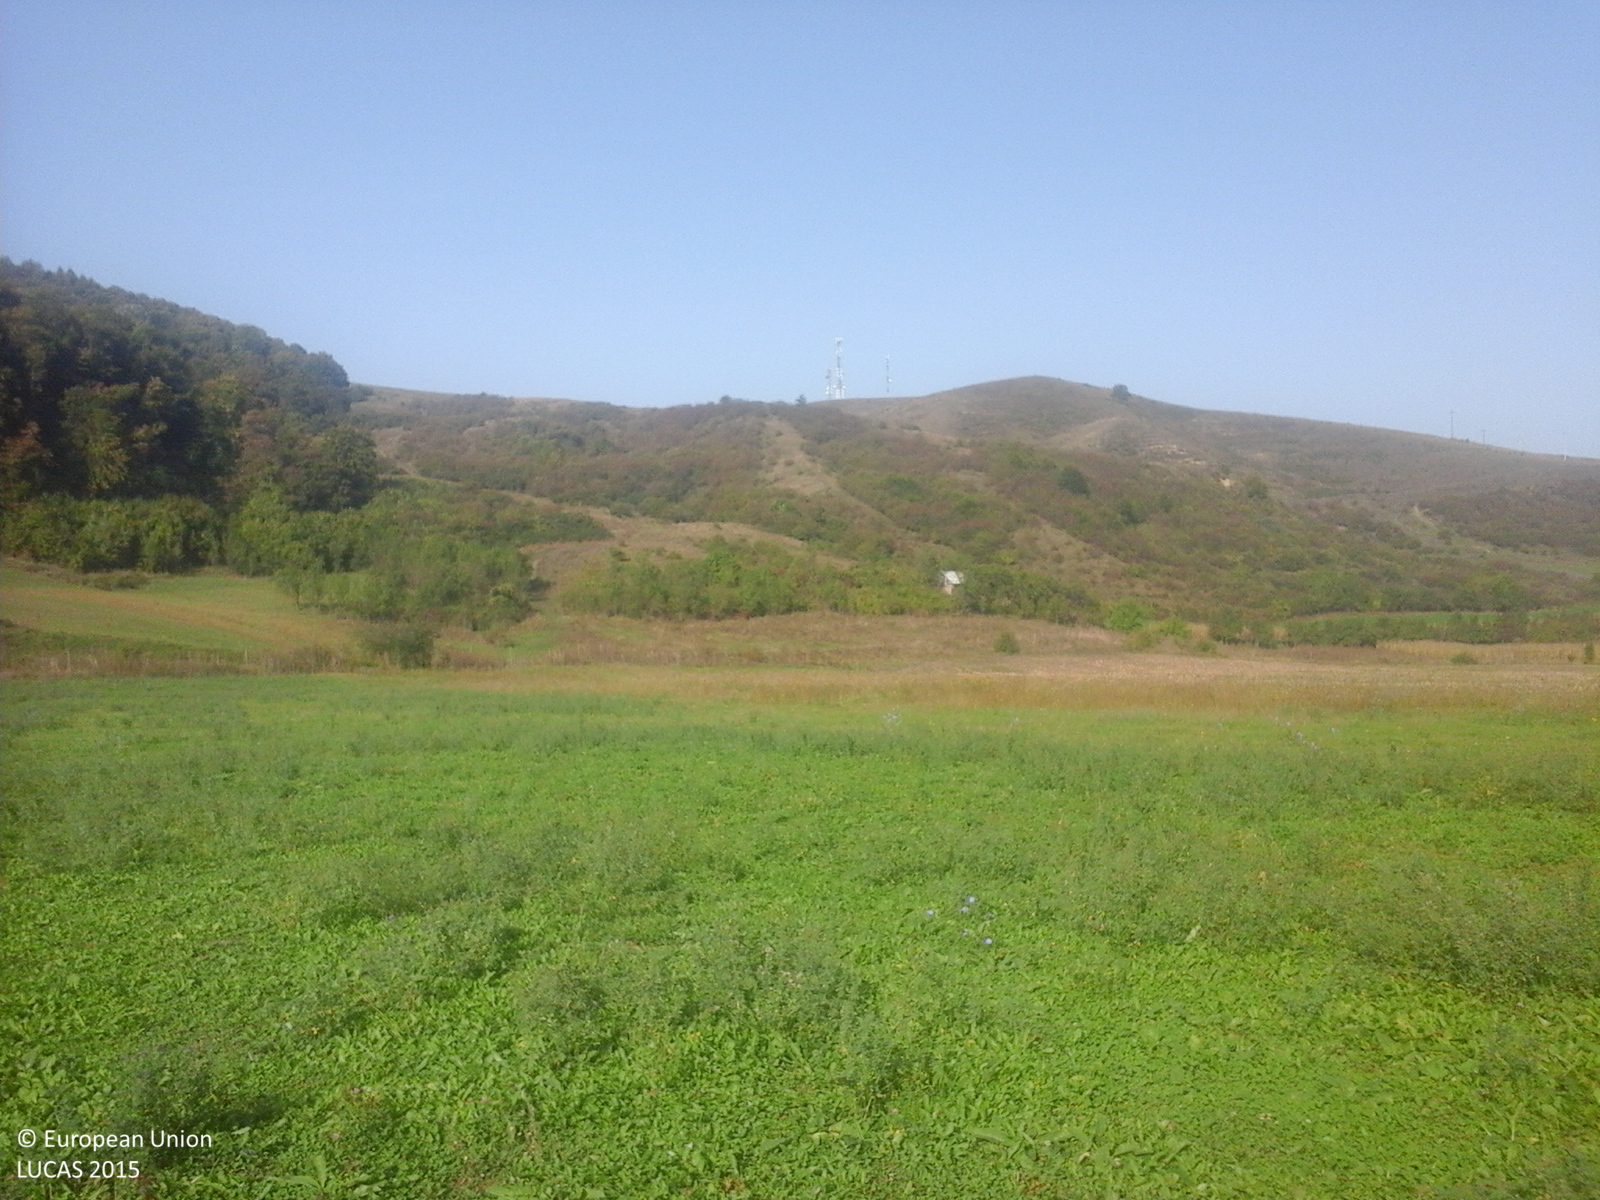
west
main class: Cropland
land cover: Other leguminous and mixtures for fodder
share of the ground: > 75 %
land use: Agriculture (excluding fallow land and kitchen gardens)
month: September
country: RO
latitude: 47.0229
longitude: 23.9331
